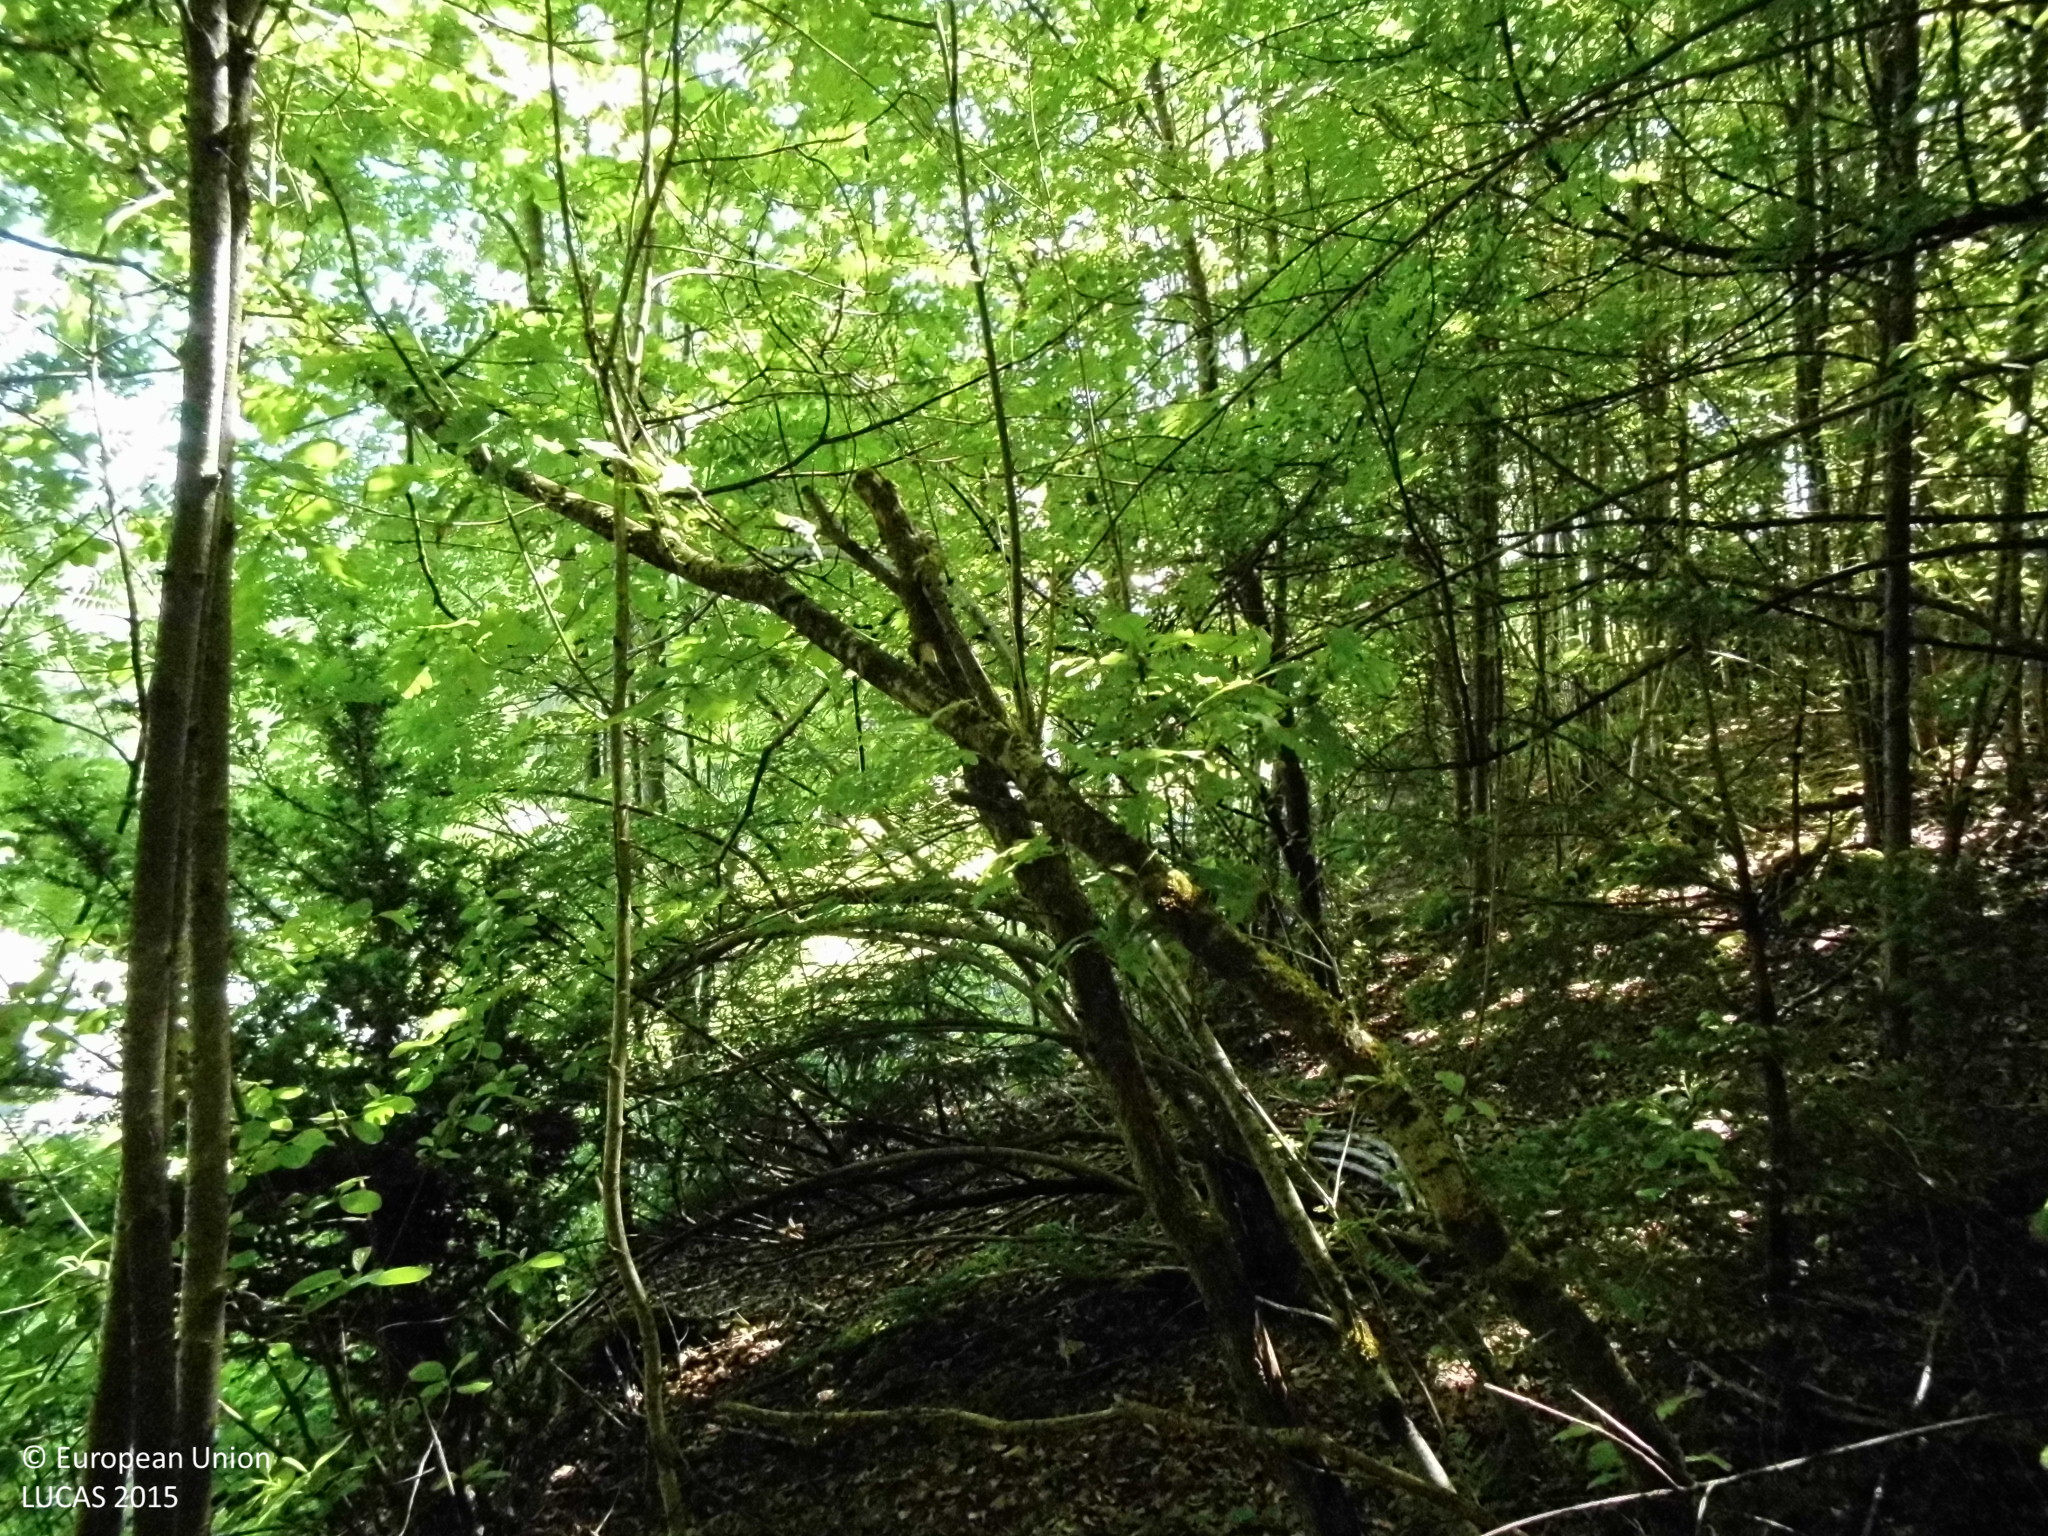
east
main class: Woodland
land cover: Broadleaved woodland
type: mesophytic deciduous forest
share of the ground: > 75 %
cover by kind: broadleaved forest trees 85 %, coniferous forest trees 15 %
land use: Forestry
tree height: > 5 m
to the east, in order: Broadleaved woodland; Shruby margins; Tracks; Other mixed woodland; Artificial constructions in urban areas; Floriculture and ornamental plants; Fences; Rivers and streams; Spontaneously vegetated surfaces
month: June
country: DE
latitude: 50.9220
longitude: 7.9945
